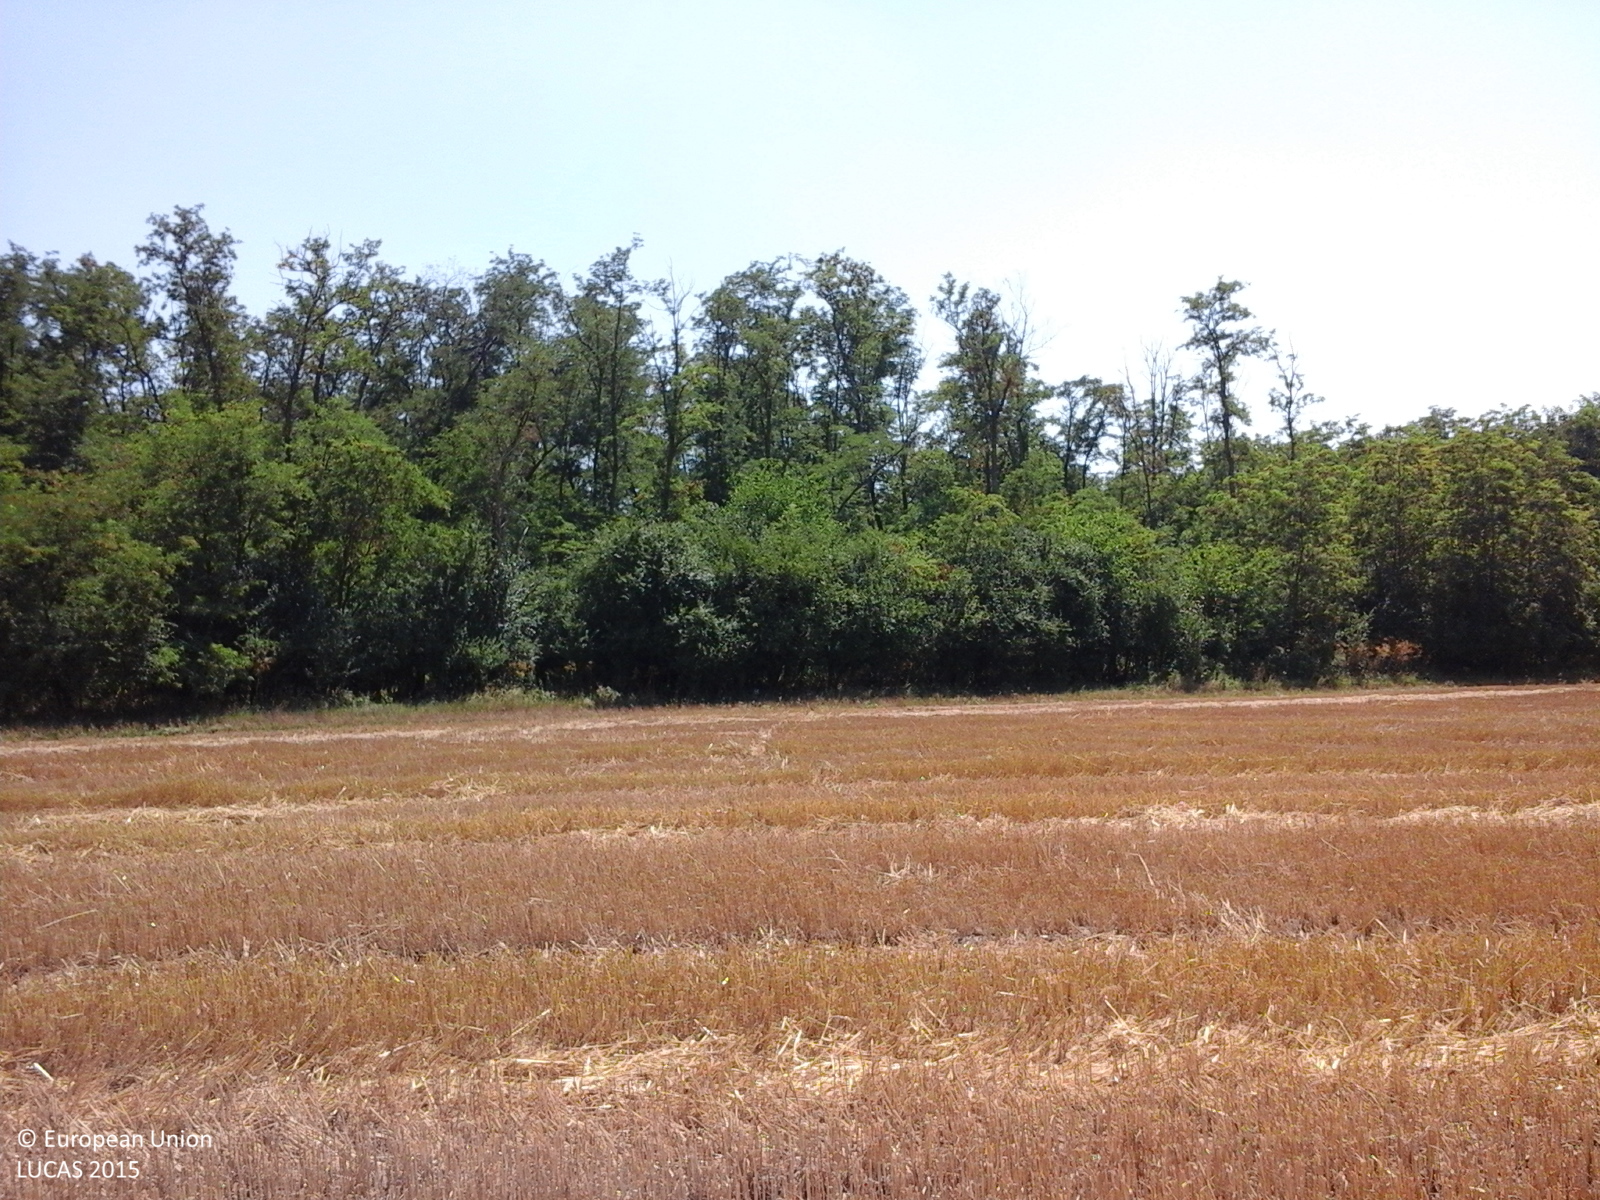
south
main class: Cropland
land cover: Durum wheat
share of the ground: > 75 %
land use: Agriculture (excluding fallow land and kitchen gardens)
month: July
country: RO
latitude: 44.2644
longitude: 26.9739
